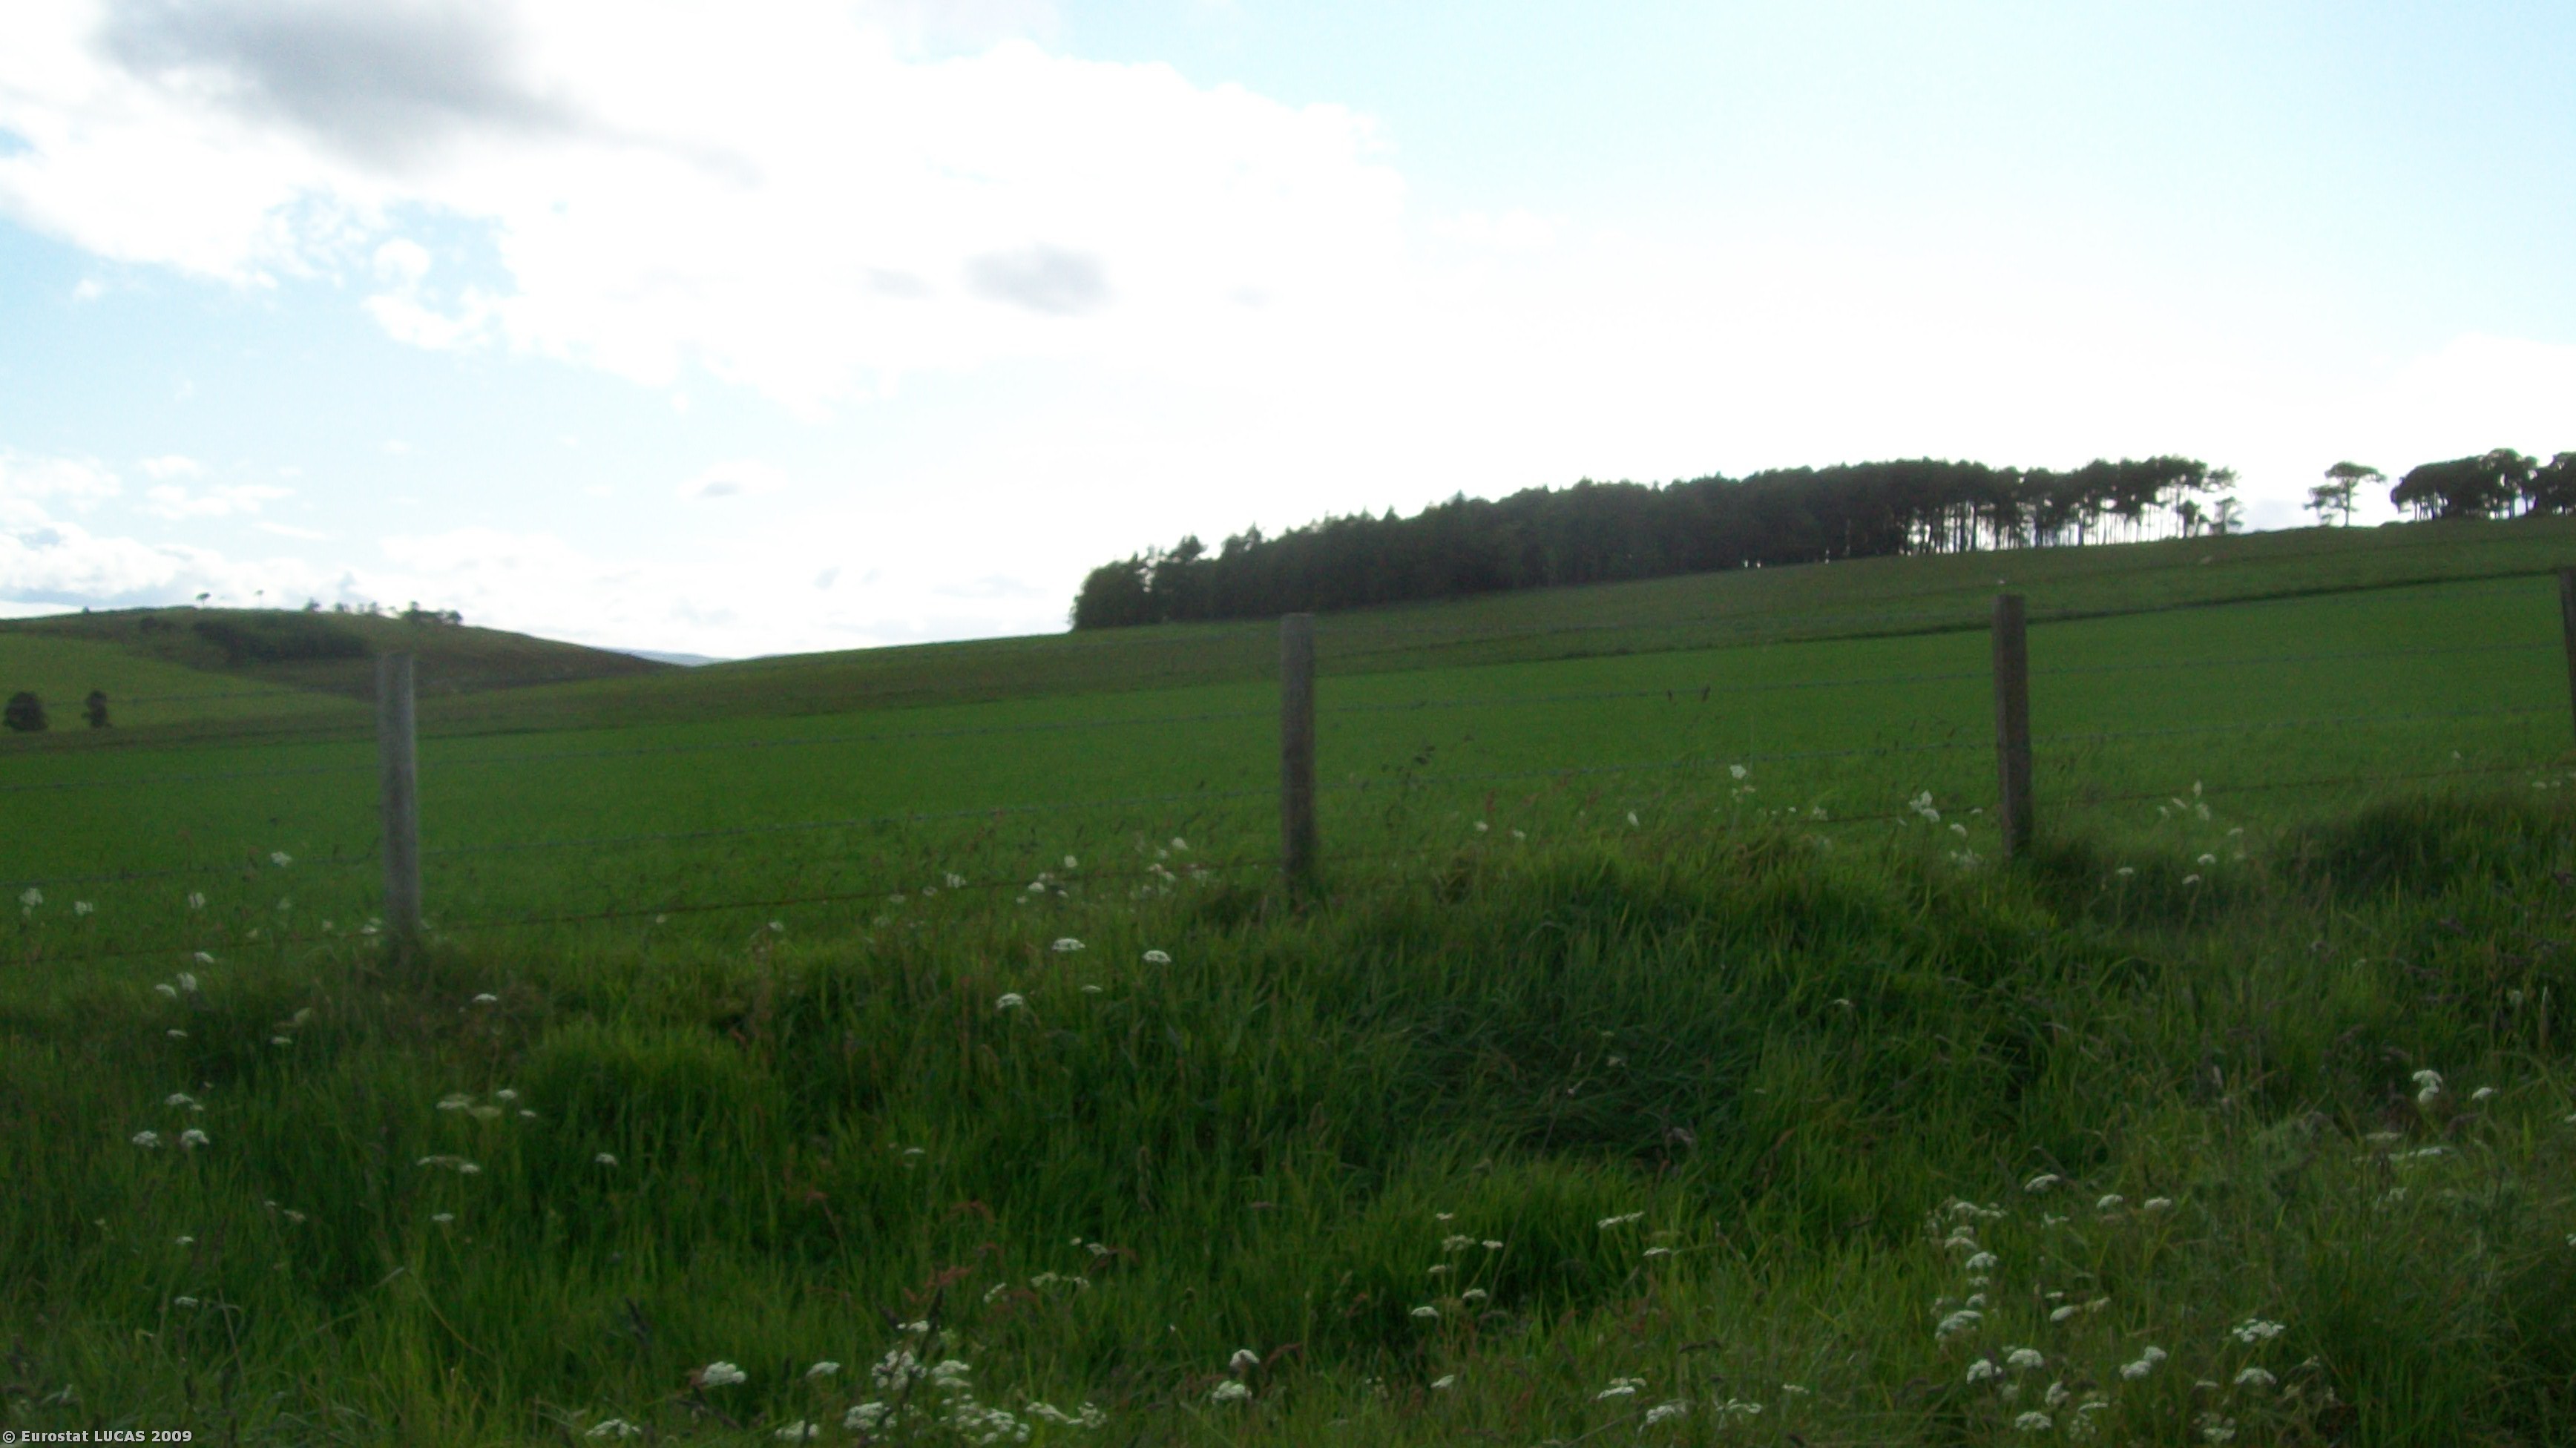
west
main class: Woodland
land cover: Mixed woodland
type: plantations and self-sown exotic forest
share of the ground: > 75 %
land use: Unused
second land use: Nature reserves
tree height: > 5 m
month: June
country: GB
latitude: 57.4796
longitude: -2.5792
